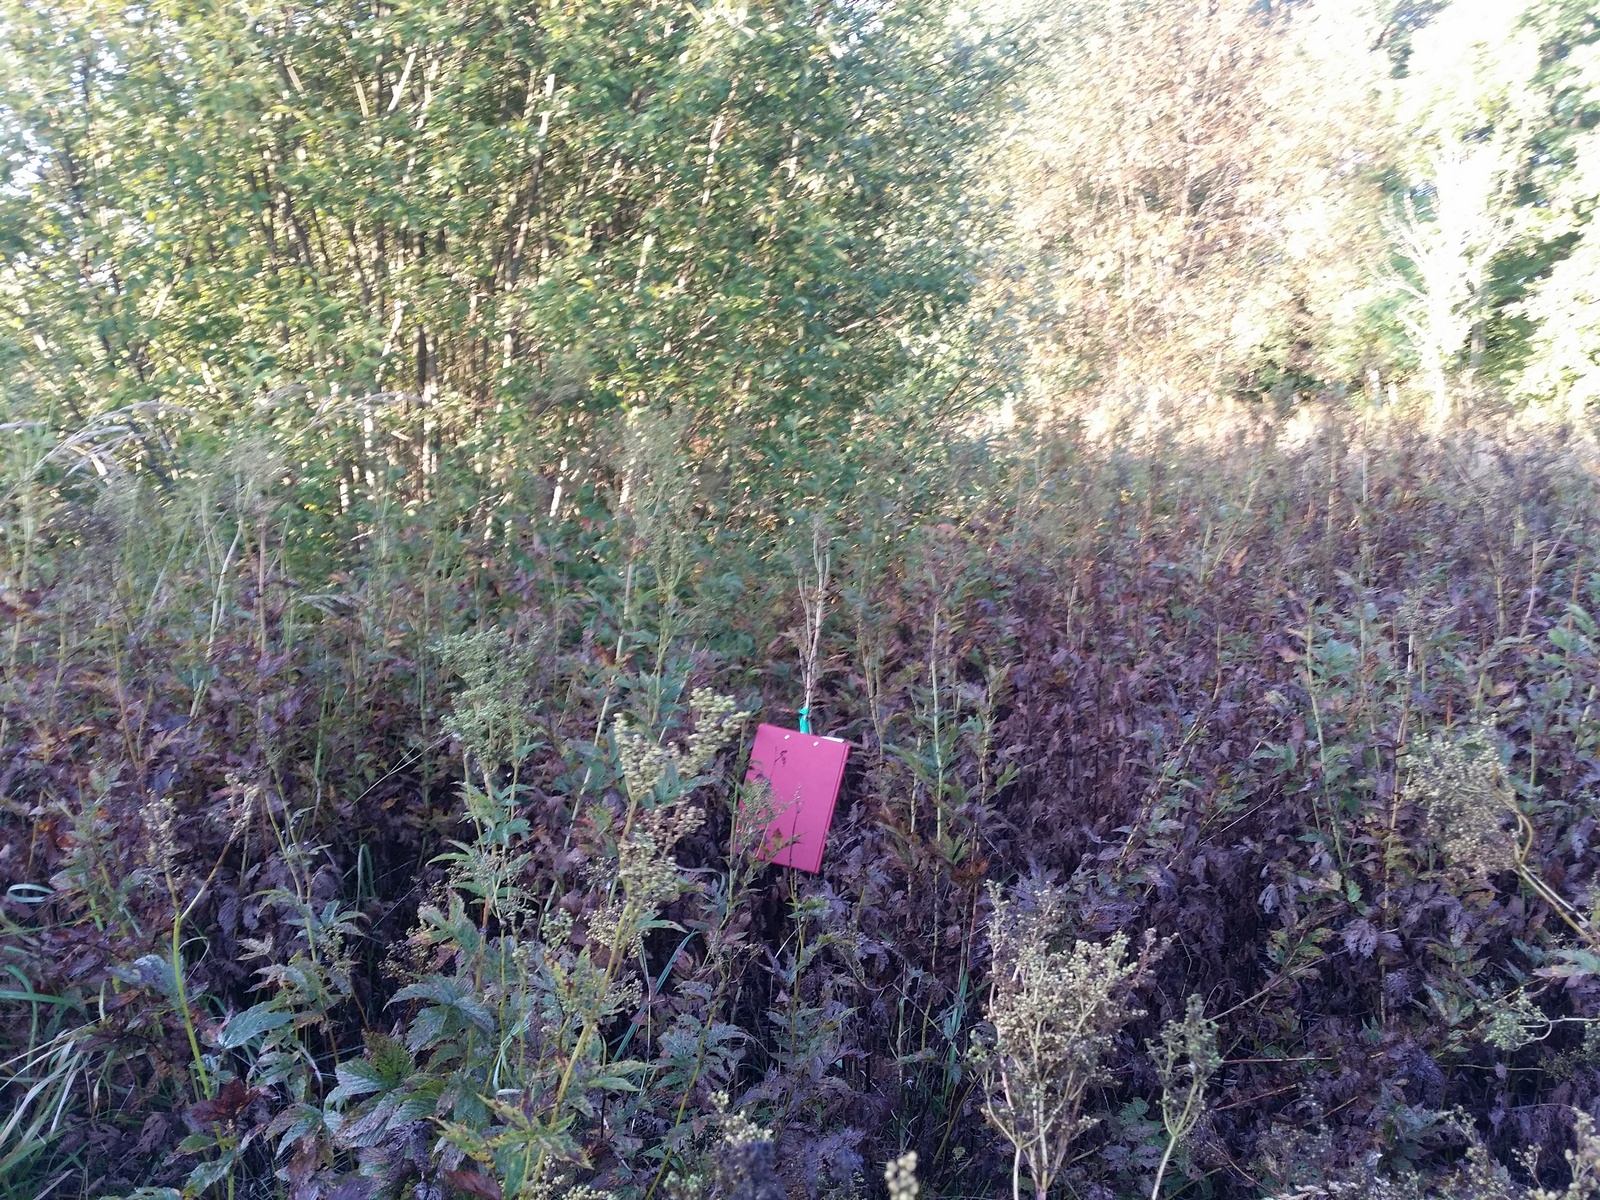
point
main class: Shrubland
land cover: Shrubland without tree cover
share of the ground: 25 - 50 %
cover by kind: herbaceous plants 65 %, shrubs 35 %
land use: Semi-natural and natural areas not in use
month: September
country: LV
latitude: 57.0645
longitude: 27.1680
